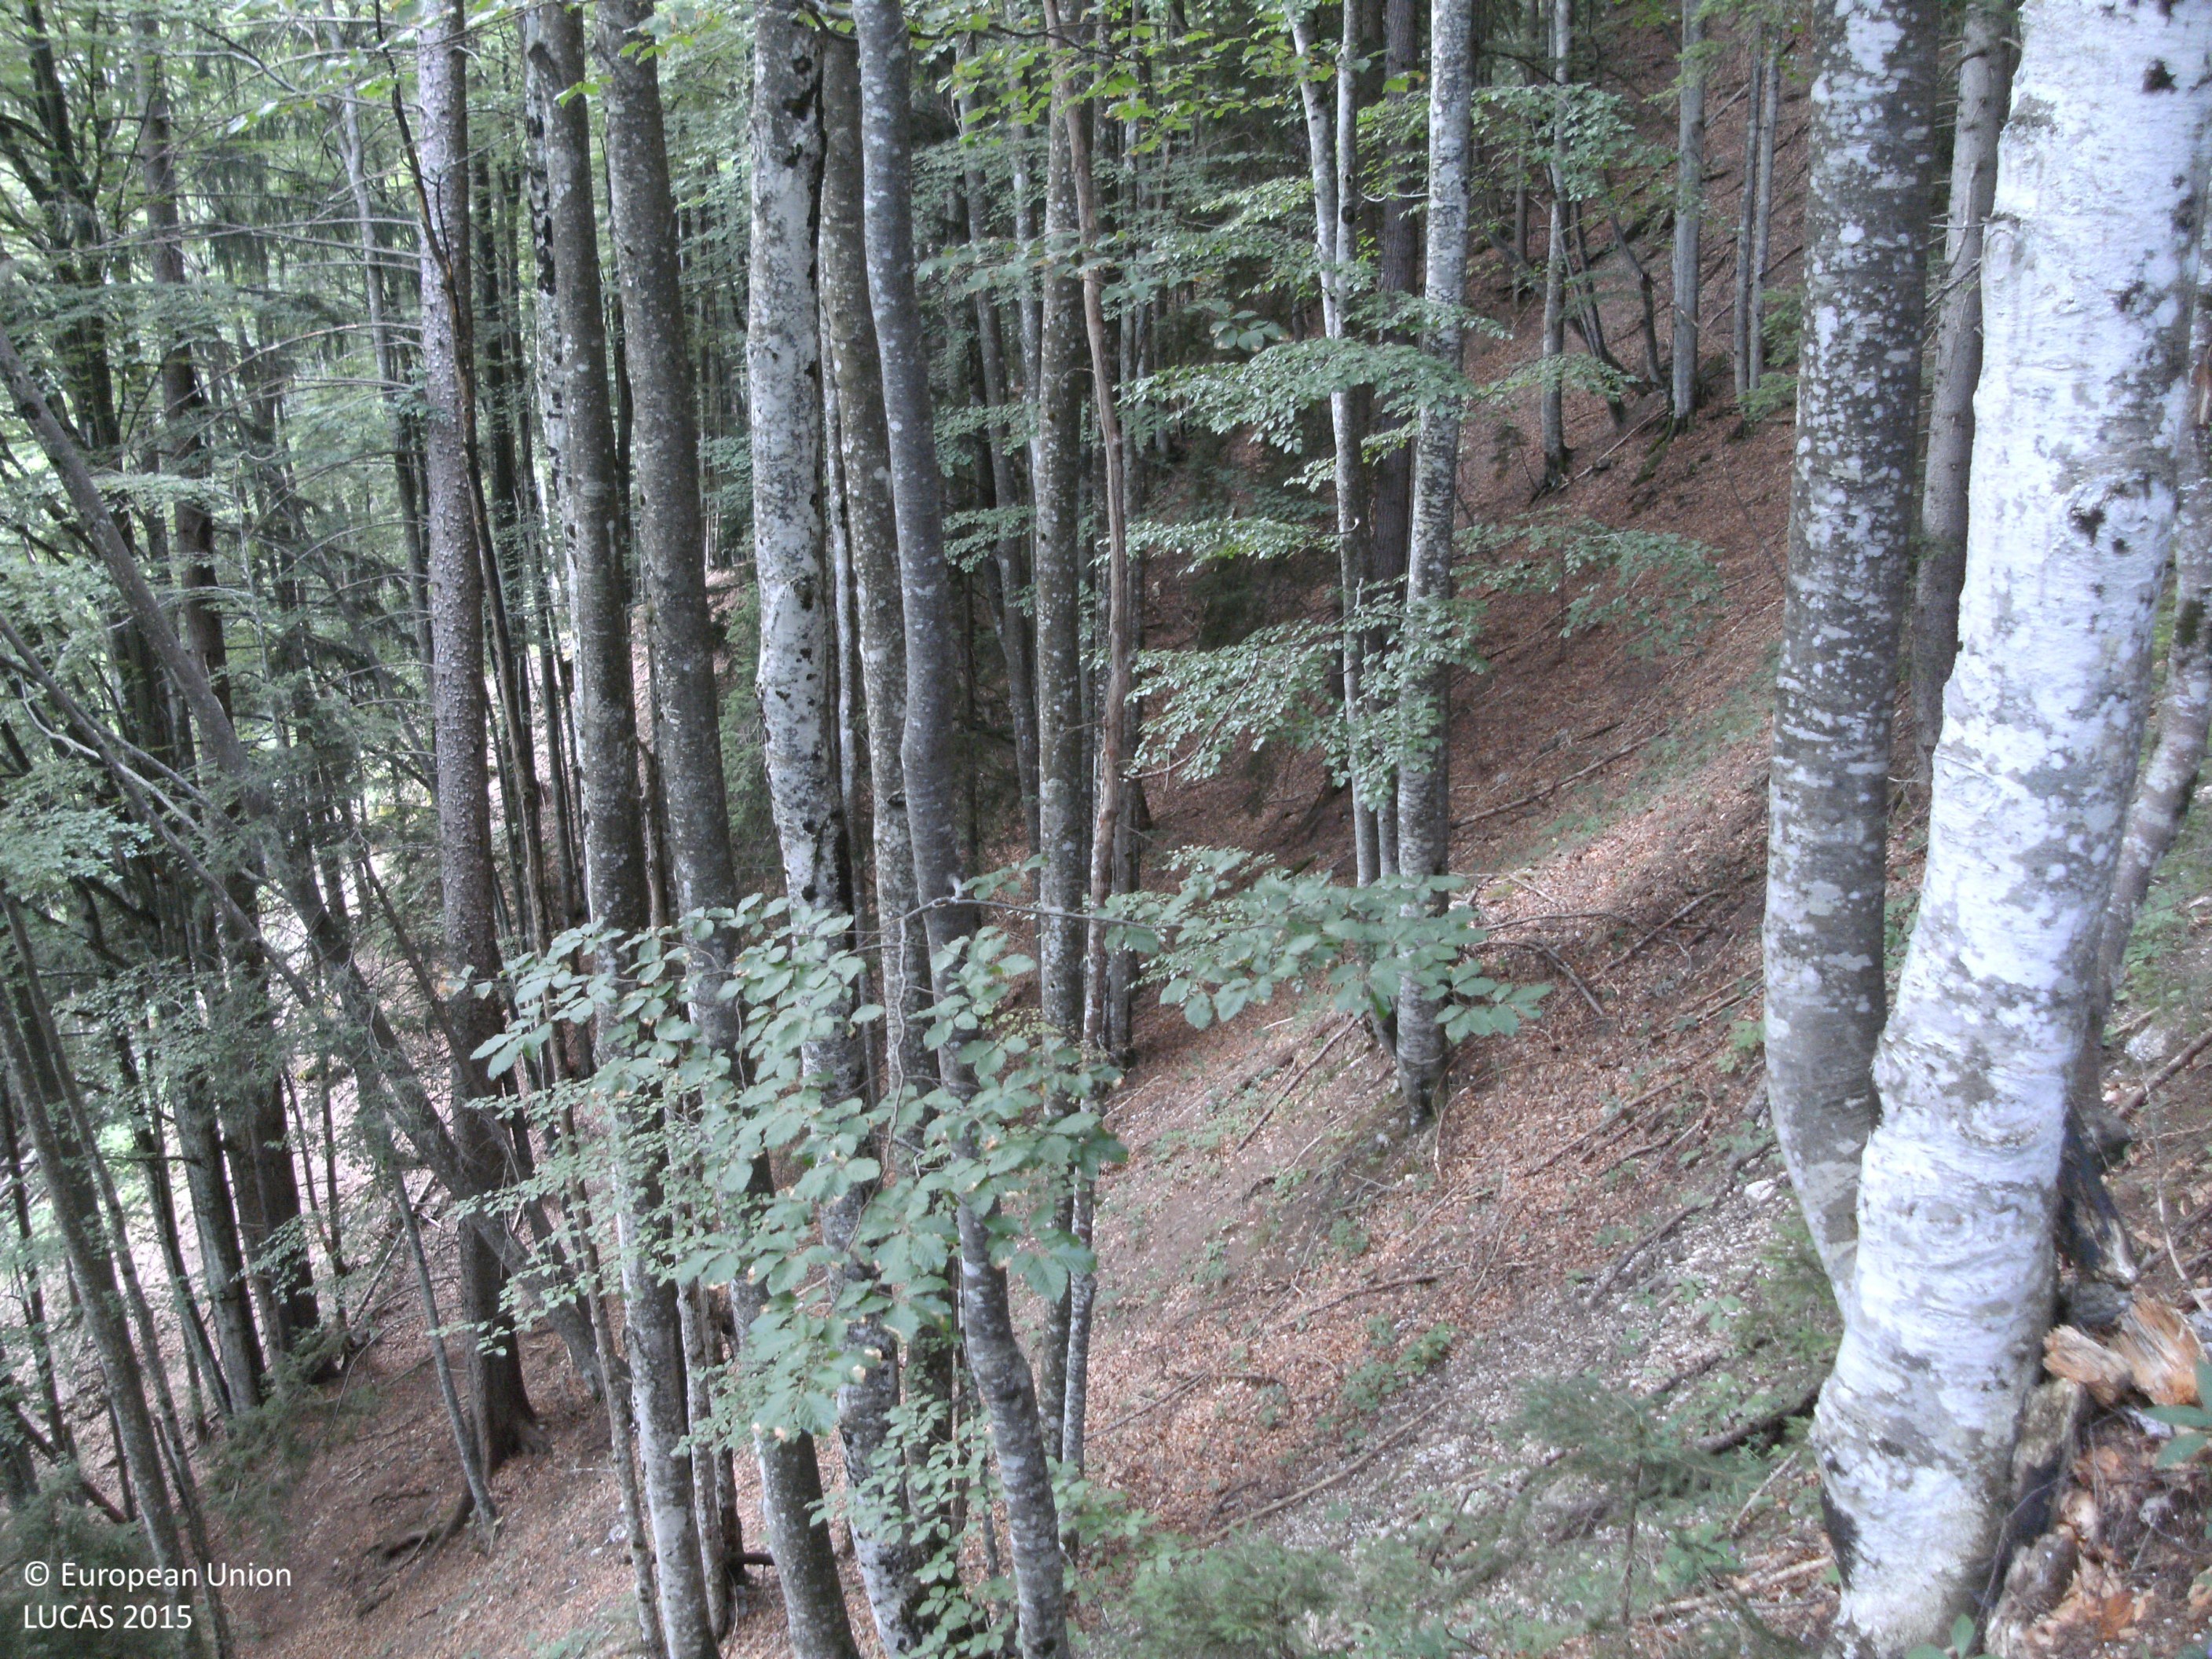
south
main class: Woodland
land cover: Other mixed woodland
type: mountainous beech forest
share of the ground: > 75 %
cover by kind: broadleaved forest trees 50 %, coniferous forest trees 45 %, consolidated bare surface 5 %
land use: Forestry
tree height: > 5 m
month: July
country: AT
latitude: 46.3982
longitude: 14.5623
